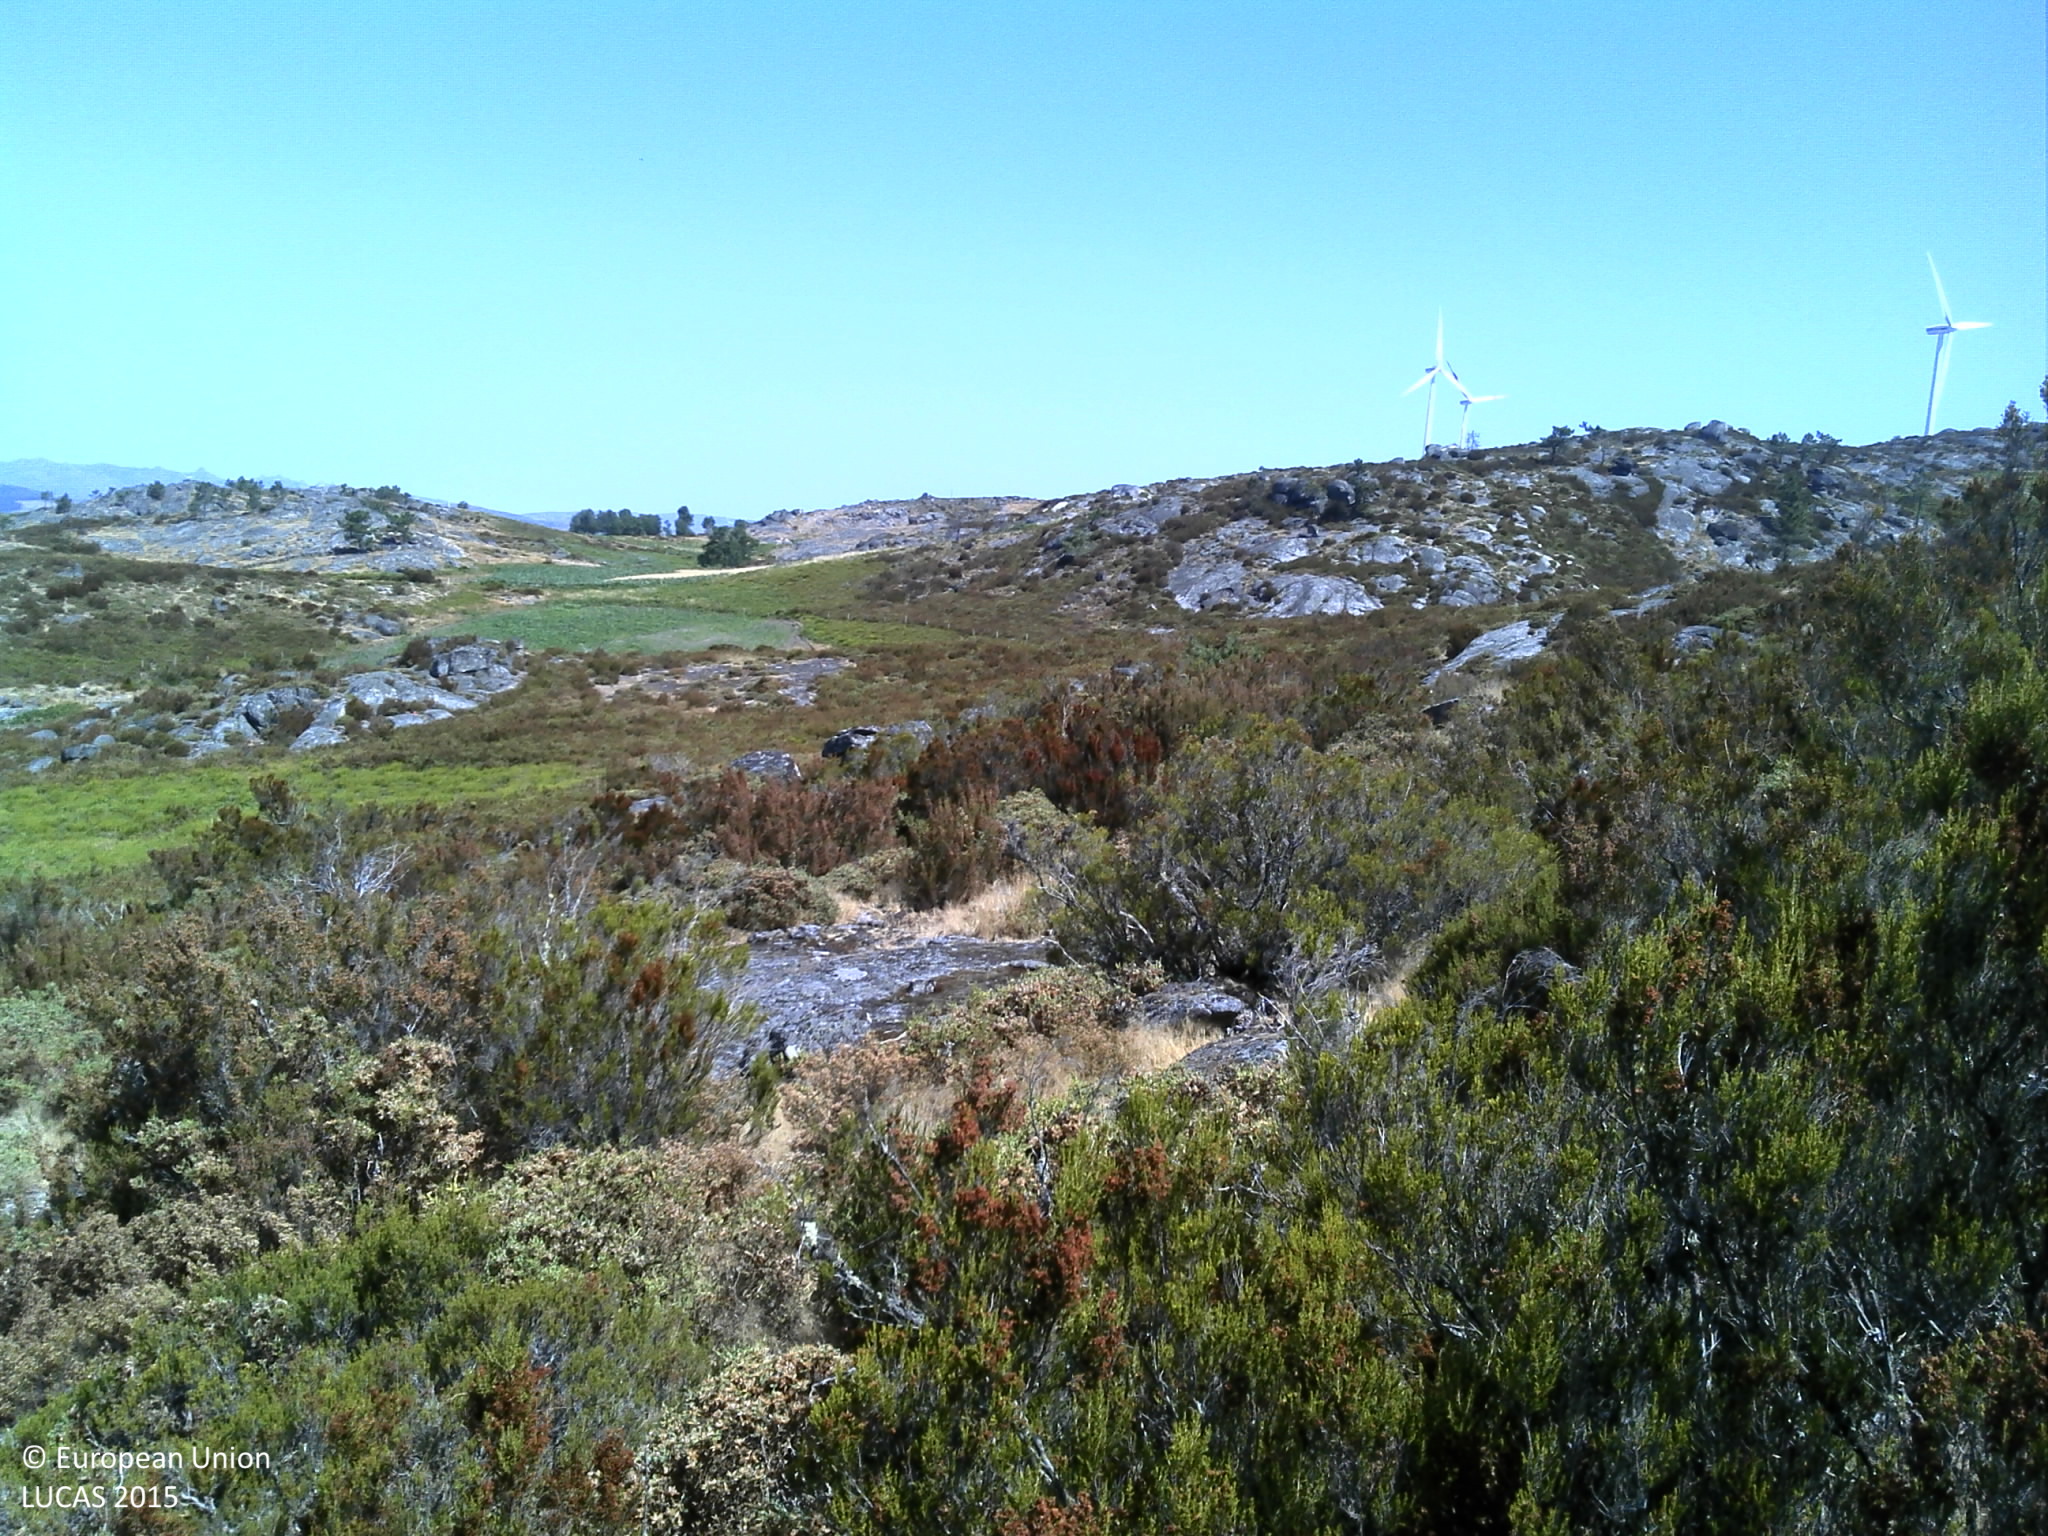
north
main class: Shrubland
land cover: Shrubland without tree cover
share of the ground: > 75 %
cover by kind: shrubs 75 %, consolidated bare surface 25 %
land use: Agriculture (excluding fallow land and kitchen gardens)
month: July
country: PT
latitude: 41.6748
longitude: -7.8817
